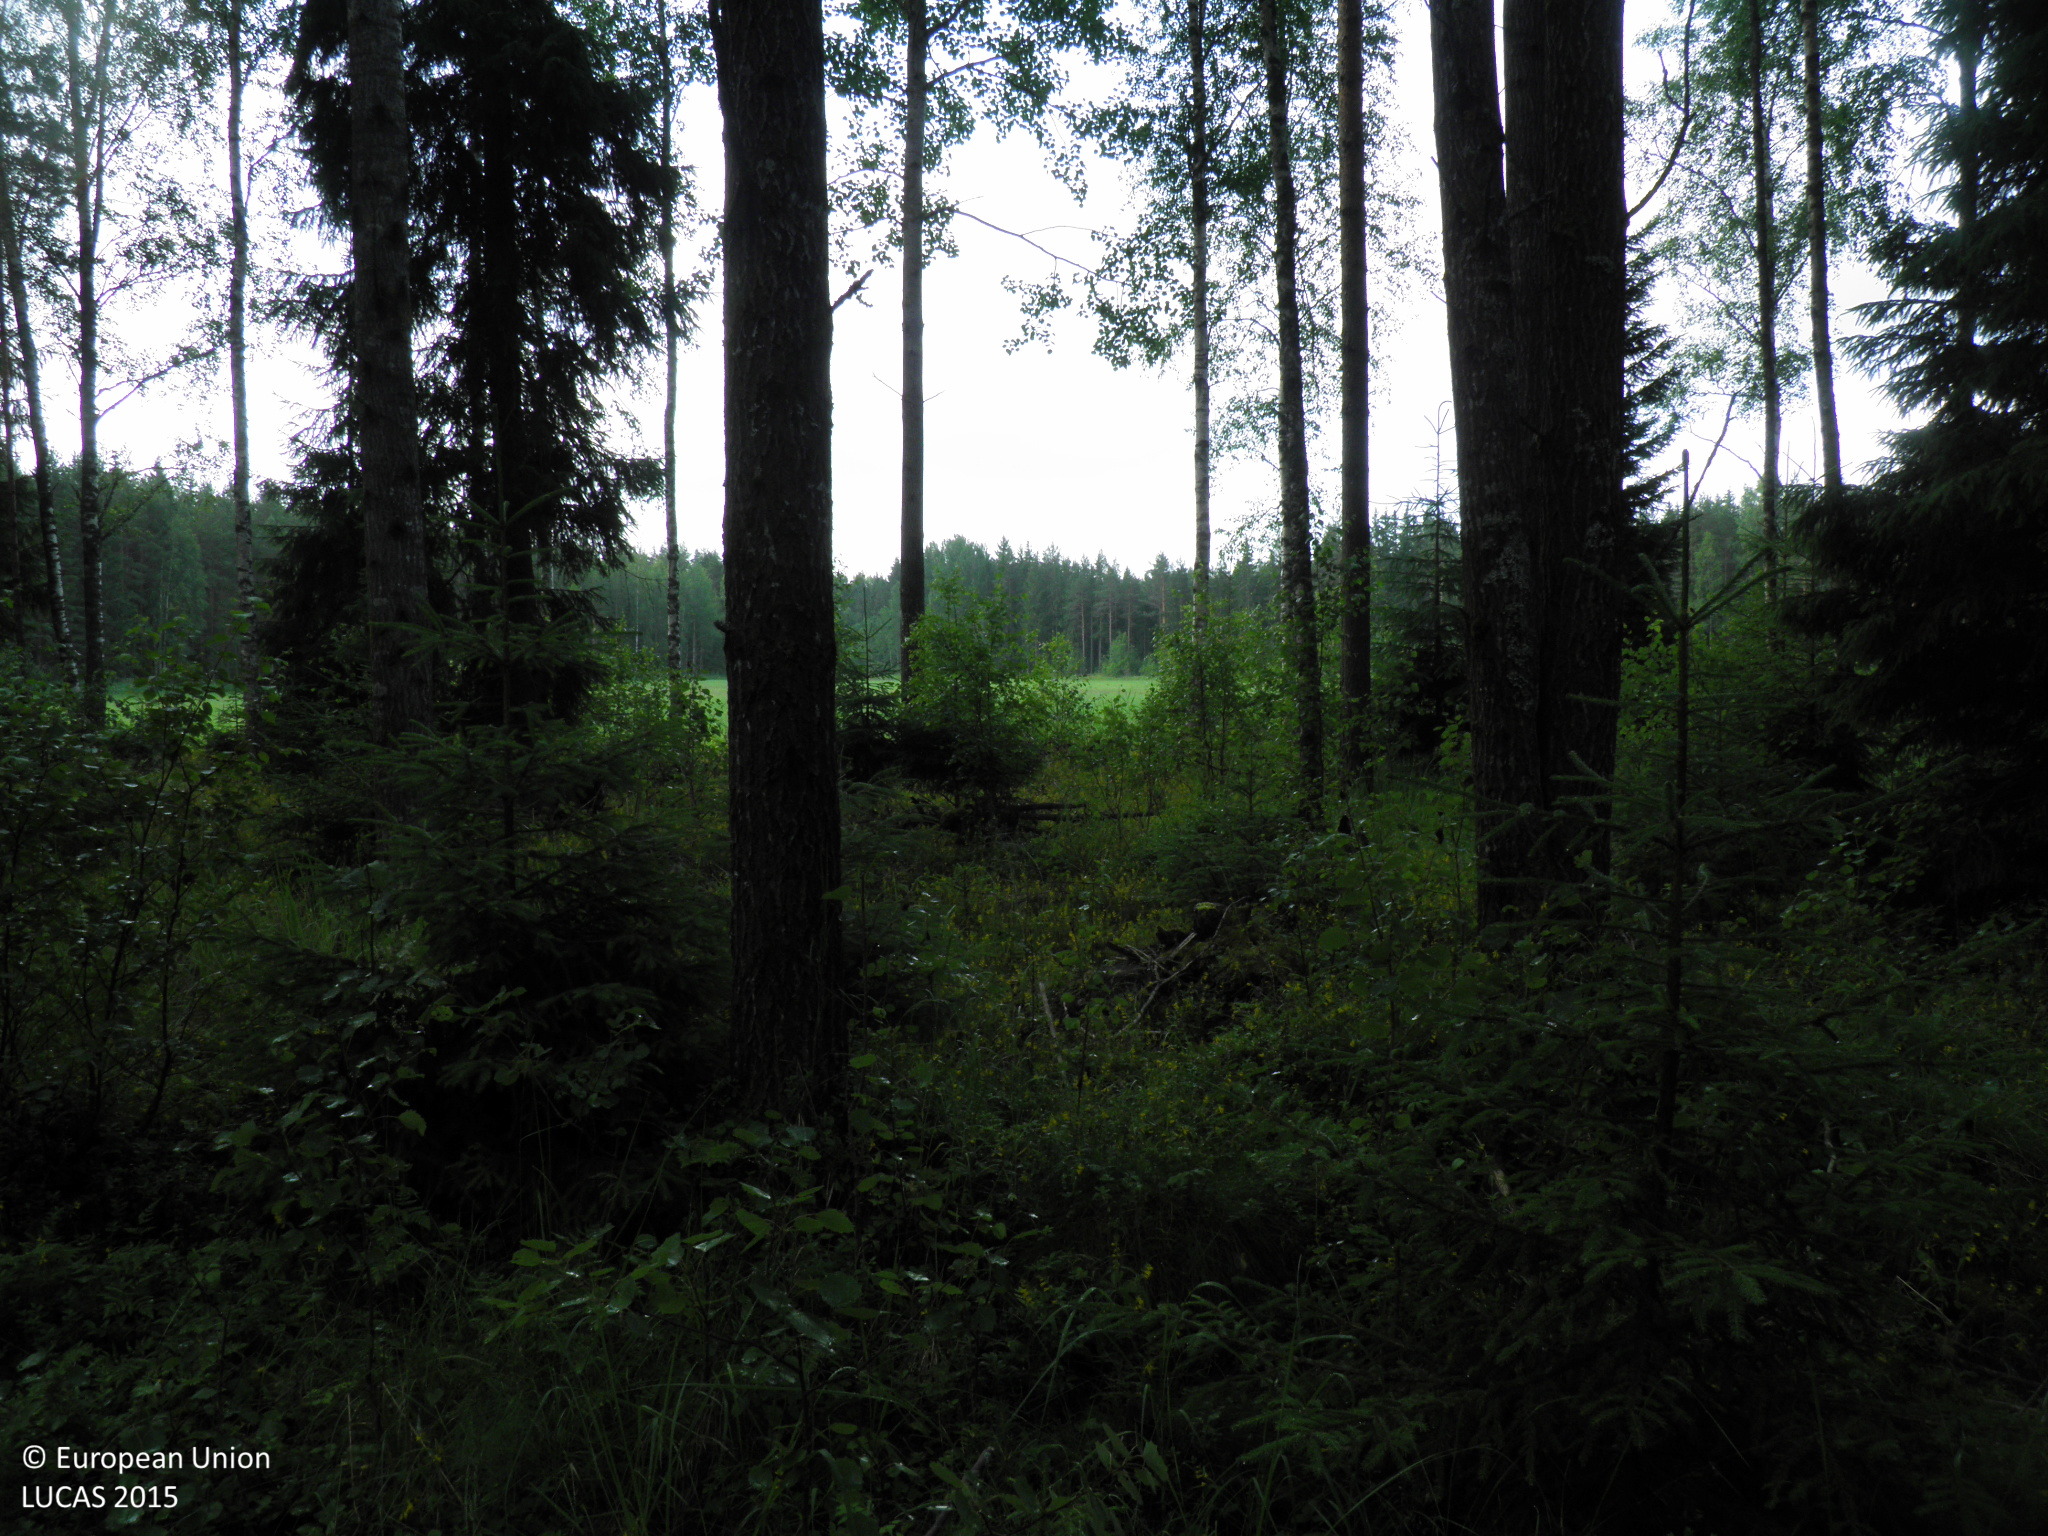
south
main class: Woodland
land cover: Other mixed woodland
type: hemiboreal forest and nemoral coniferous forest and mixed broadleaved-coniferous forest
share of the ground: 50 - 75 %
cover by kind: broadleaved forest trees 40 %, coniferous forest trees 20 %, shrubs 20 %, herbaceous plants 20 %
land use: Forestry
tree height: > 5 m
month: July
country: FI
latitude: 60.6699
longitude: 22.4214
